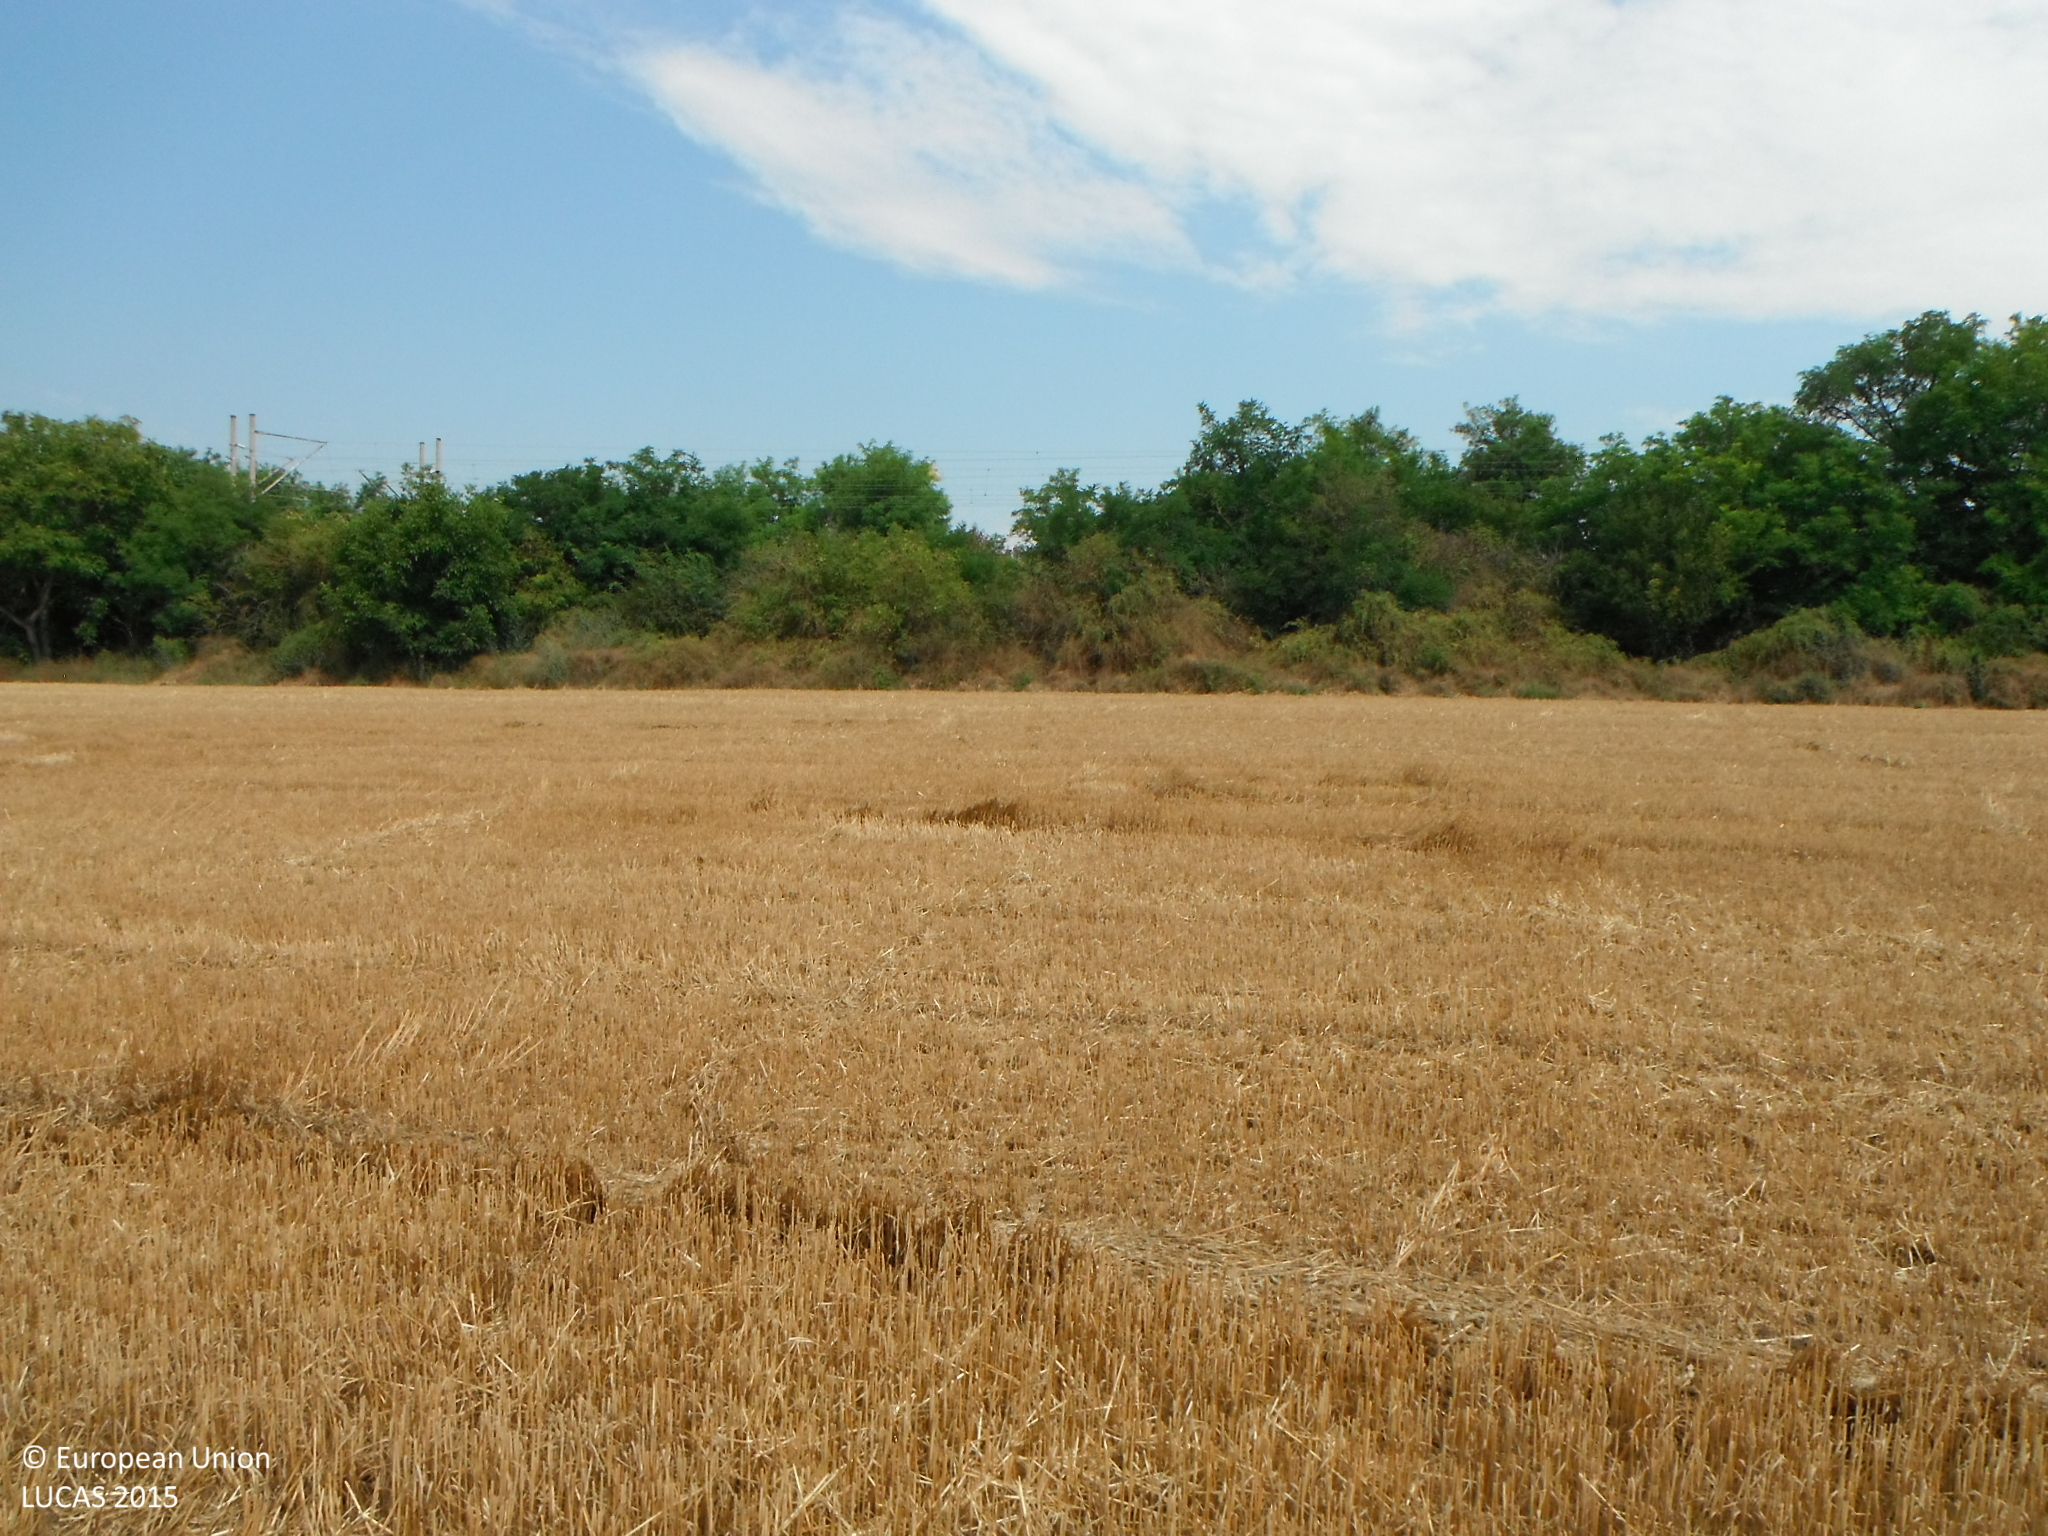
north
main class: Cropland
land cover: Common wheat
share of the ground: > 75 %
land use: Agriculture (excluding fallow land and kitchen gardens)
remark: Harvested field
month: August
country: SK
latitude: 47.8165
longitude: 18.5763
